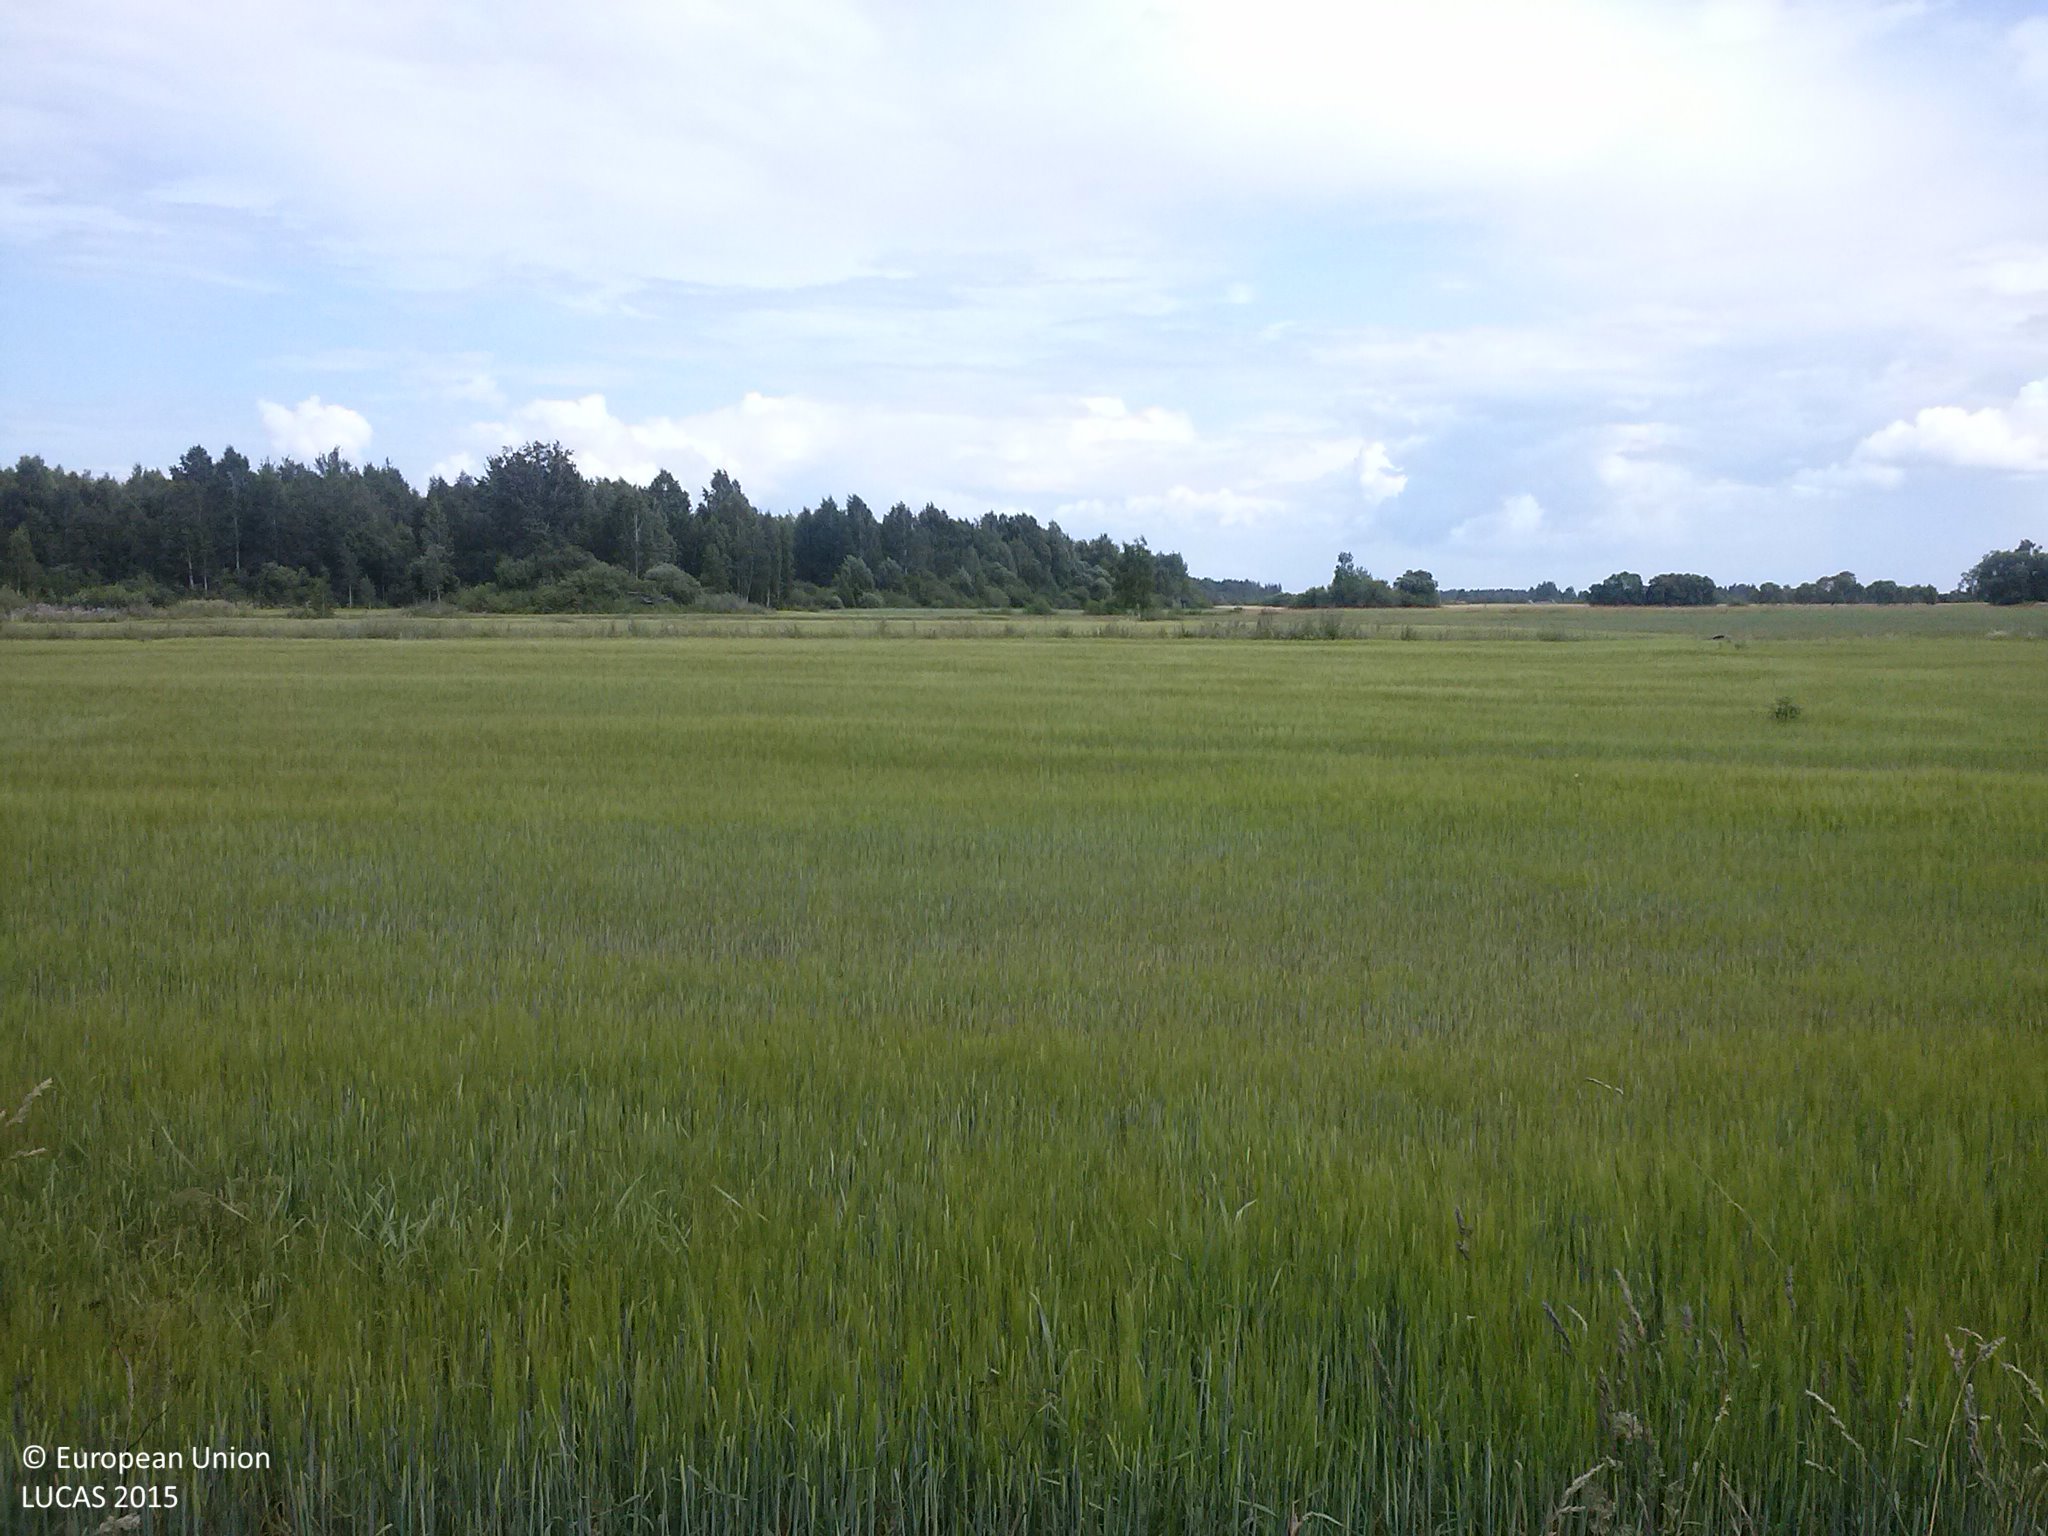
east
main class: Grassland
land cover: Spontaneously vegetated surfaces
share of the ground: > 75 %
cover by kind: herbaceous plants 100 %
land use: Fallow land
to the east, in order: Spontaneously vegetated surfaces; Barley; Spontaneously vegetated surfaces; Ditches and canals; Spontaneously vegetated surfaces; Barley; Other bare soil; Spontaneously vegetated surfaces; Ditches and canals; Spontaneously vegetated surfaces; Barley; Other bare soil; Ditches and canals; Spontaneously vegetated surfaces
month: July
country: LV
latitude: 56.7826
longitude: 27.6129
